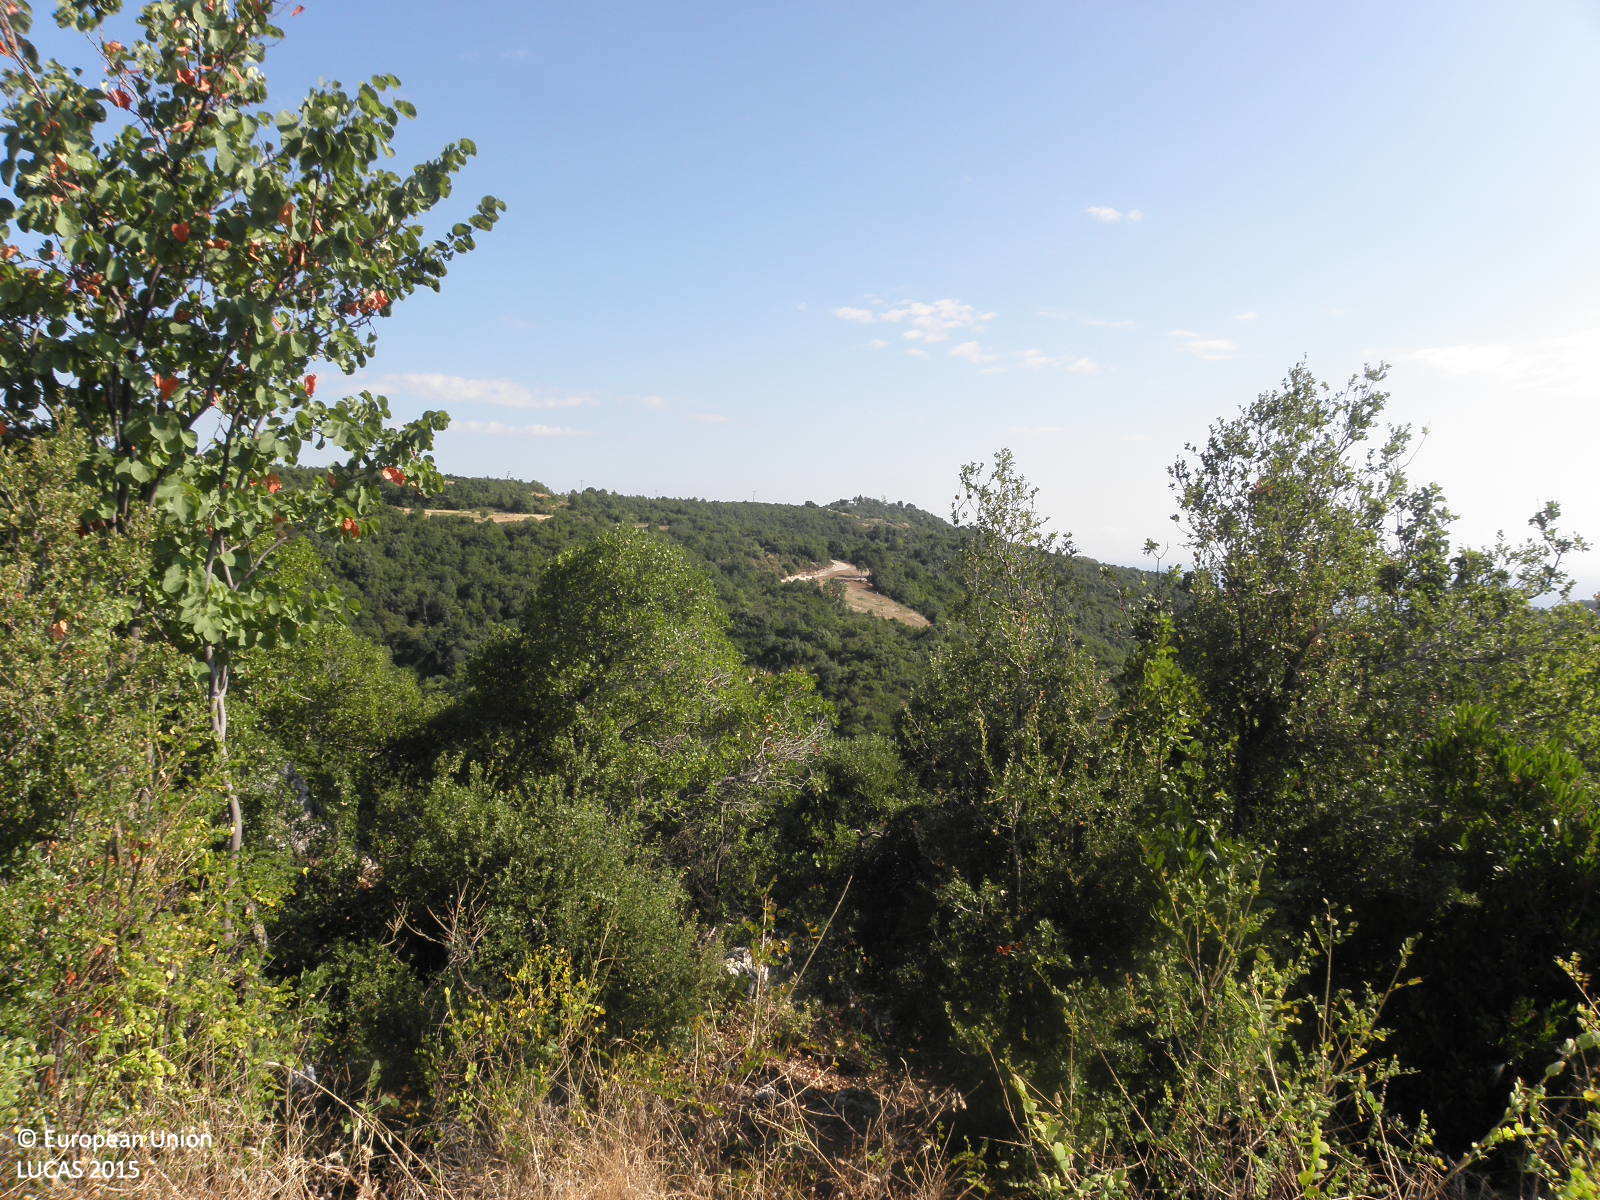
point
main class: Woodland
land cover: Broadleaved woodland
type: thermophilous deciduous forest
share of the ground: > 75 %
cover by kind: broadleaved forest trees 100 %
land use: Semi-natural and natural areas not in use
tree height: > 5 m
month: August
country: GR
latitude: 39.9452
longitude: 22.6004
